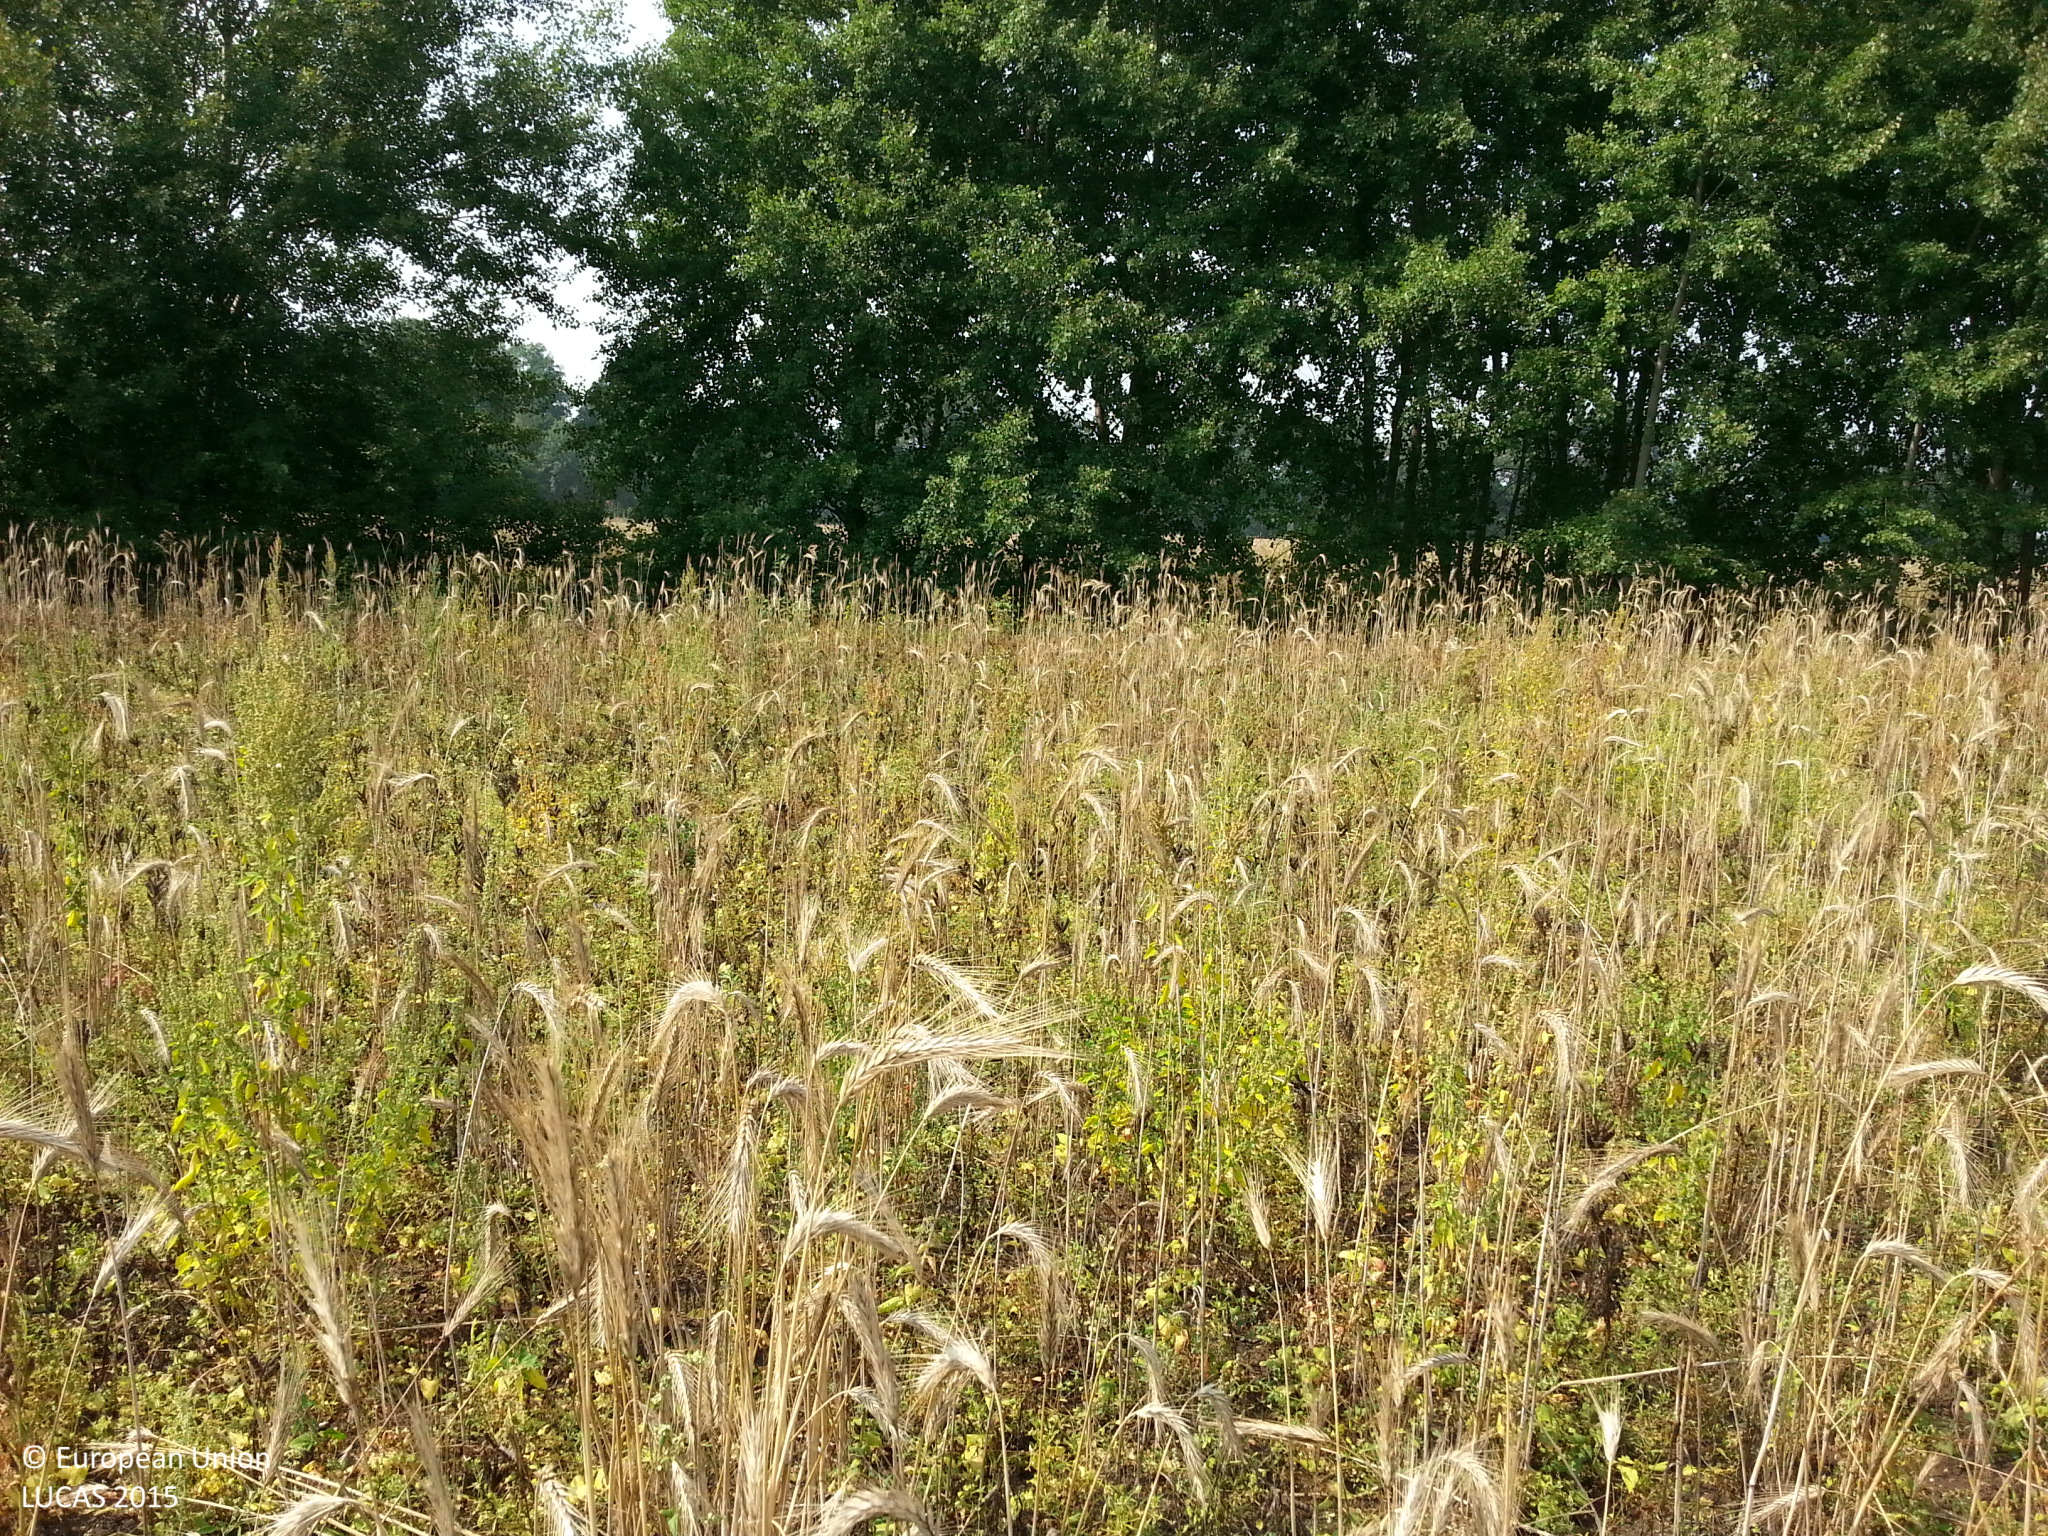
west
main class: Cropland
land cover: Triticale
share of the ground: 25 - 50 %
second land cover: Dry pulses
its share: 25 - 50 %
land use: Agriculture (excluding fallow land and kitchen gardens)
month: August
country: DE
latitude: 53.2666
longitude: 11.5137
